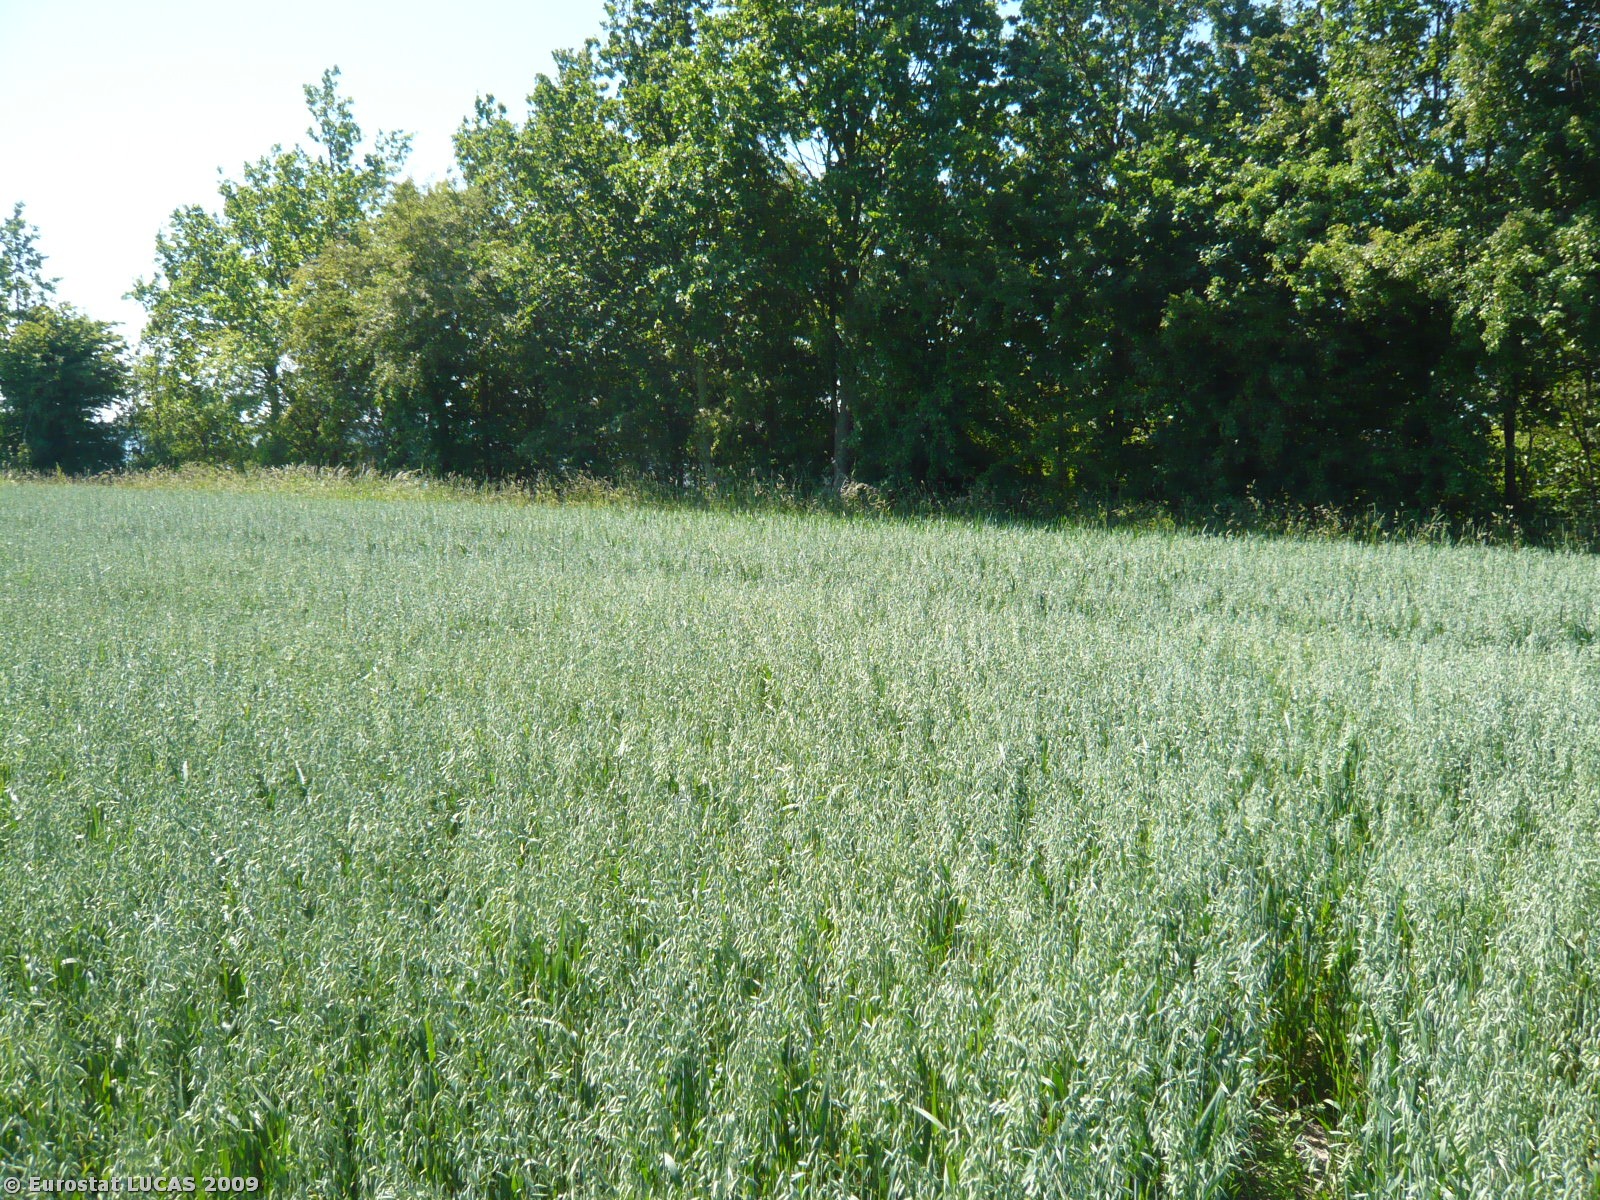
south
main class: Cropland
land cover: Oats
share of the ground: > 75 %
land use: Agriculture (excluding fallow land and kitchen gardens)
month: June
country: DK
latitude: 54.9639
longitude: 10.6399
